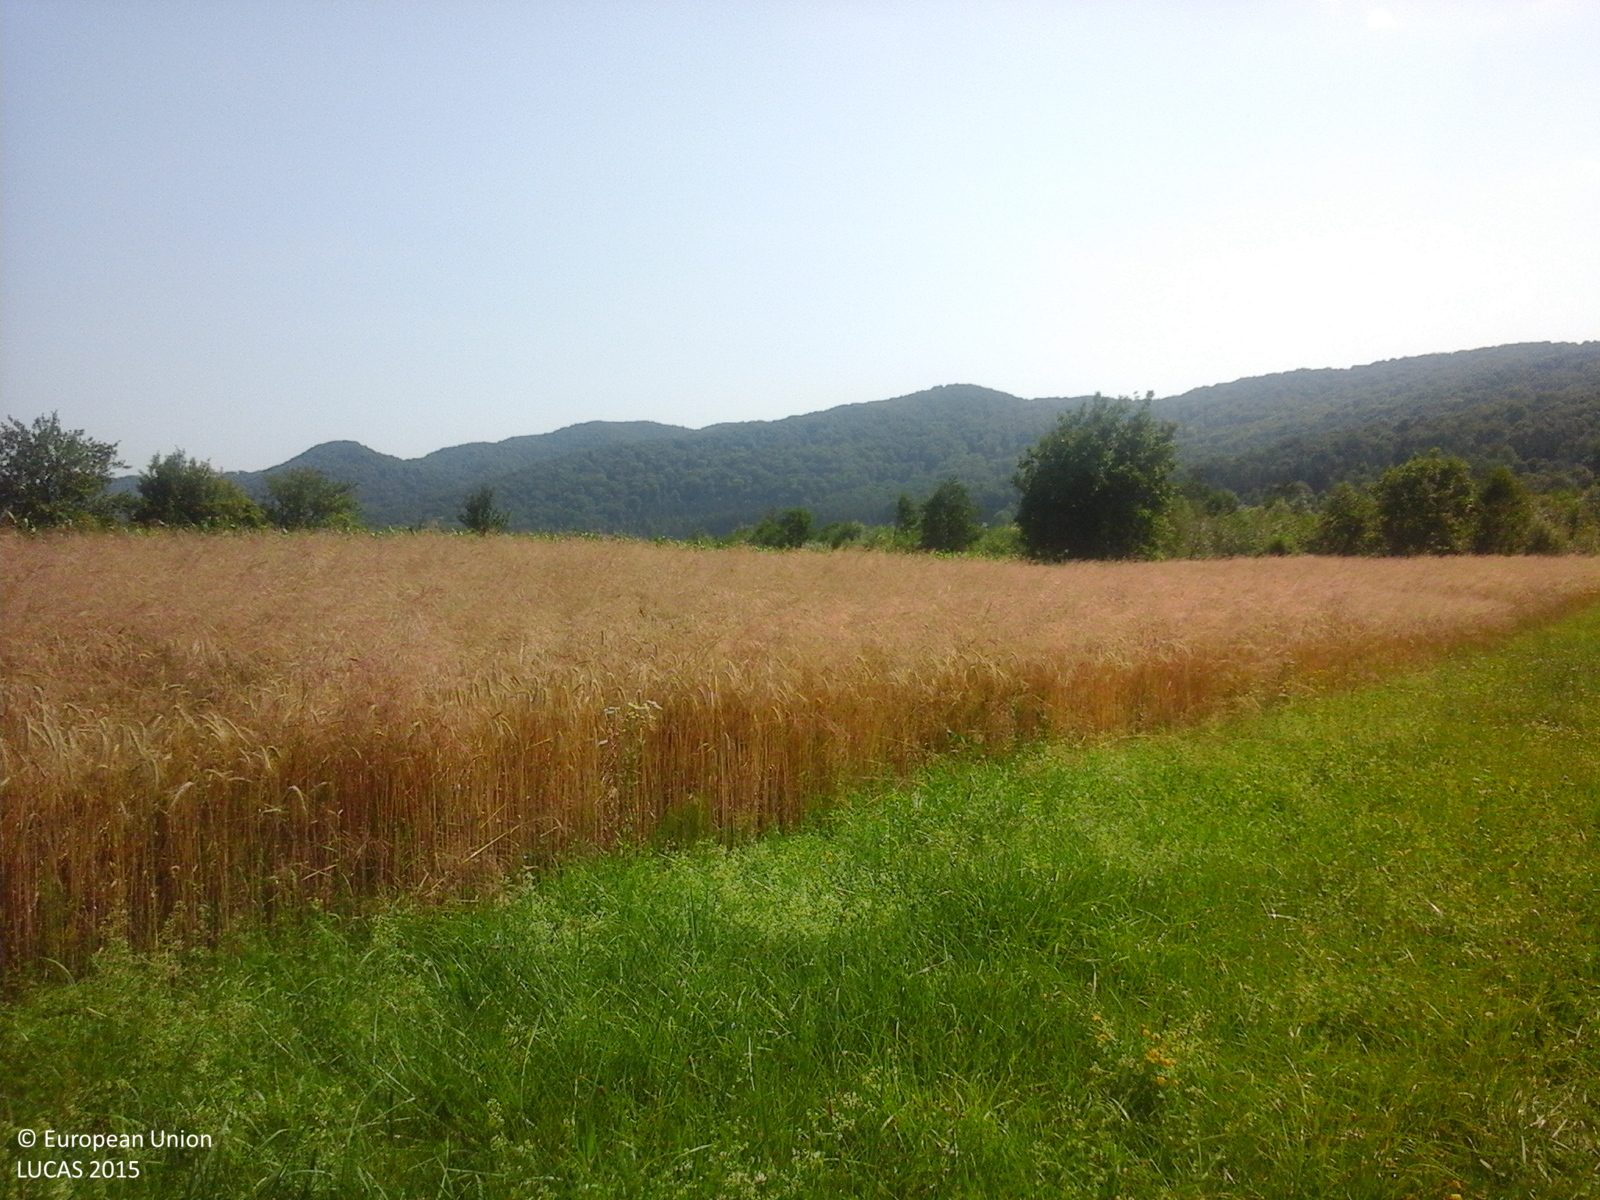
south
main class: Cropland
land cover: Lucerne
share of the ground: > 75 %
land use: Agriculture (excluding fallow land and kitchen gardens)
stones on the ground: < 10 %
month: July
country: RO
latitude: 45.1602
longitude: 24.9833
